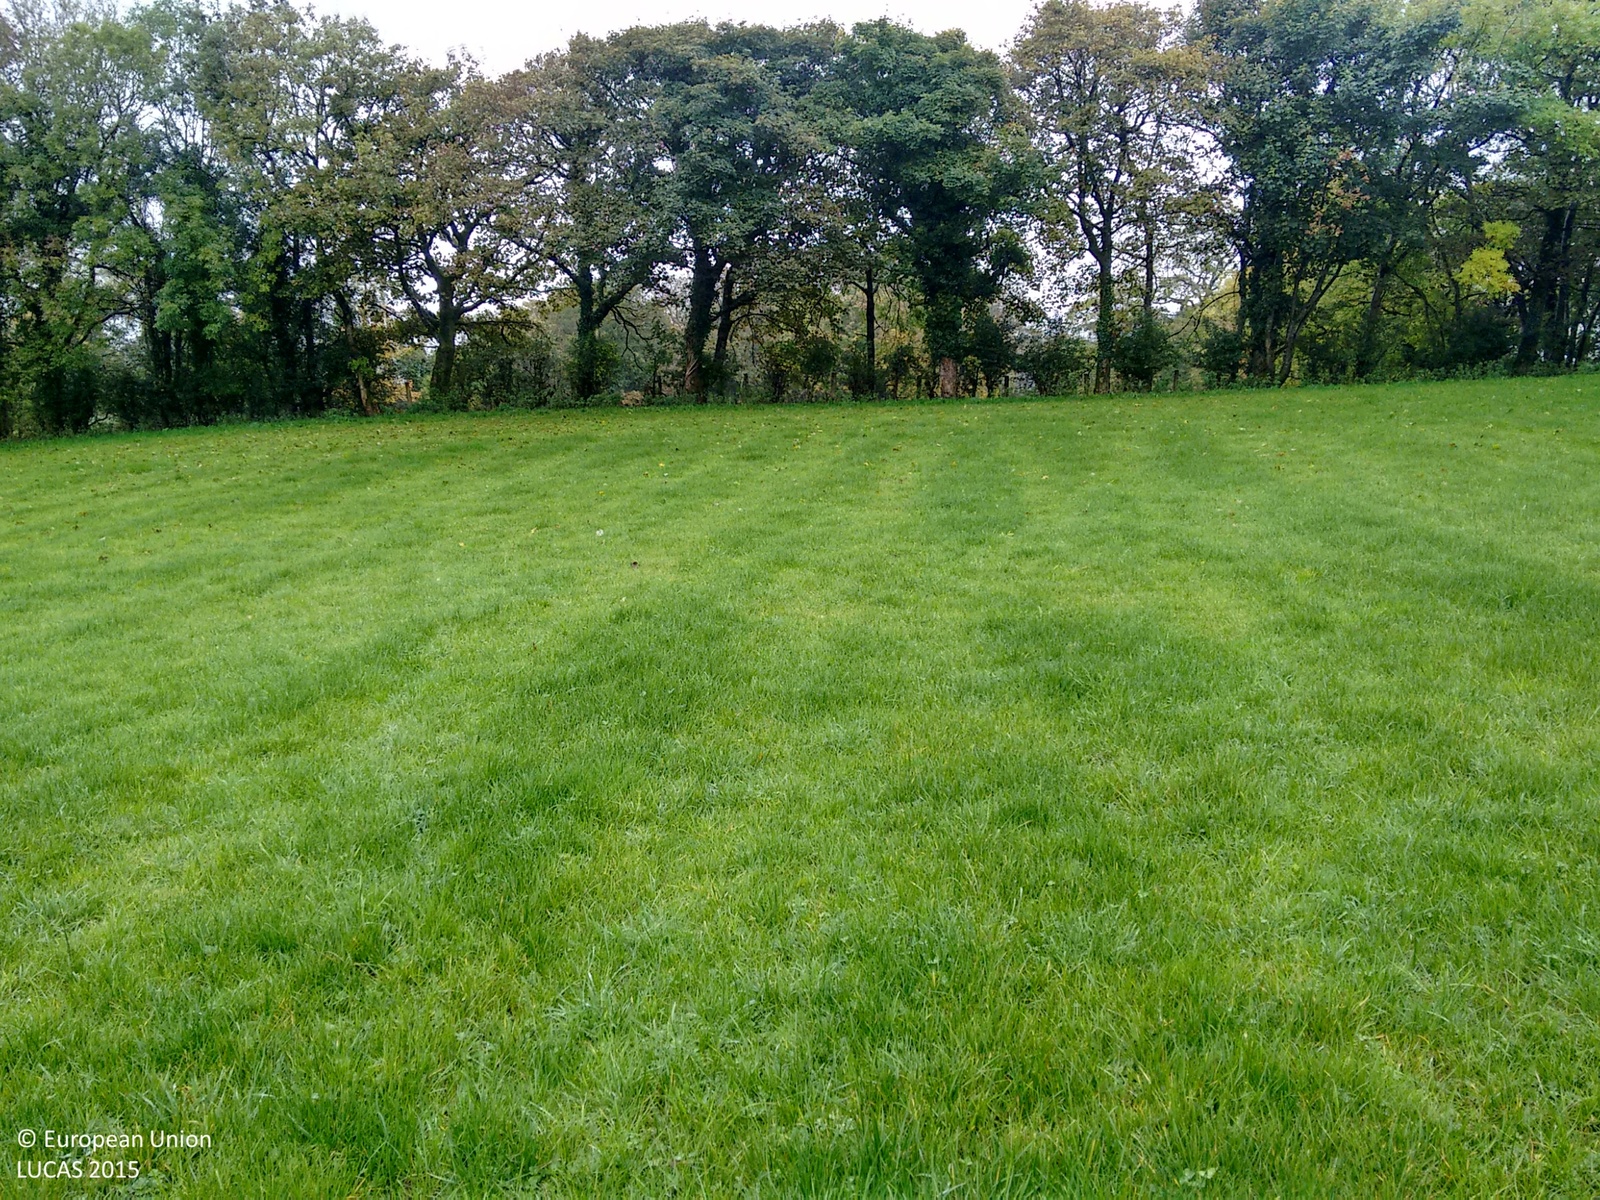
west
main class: Grassland
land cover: Grassland without tree/shrub cover
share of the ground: > 75 %
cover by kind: herbaceous plants 100 %
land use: Agriculture (excluding fallow land and kitchen gardens)
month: October
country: GB
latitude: 54.5568
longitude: -7.4251
